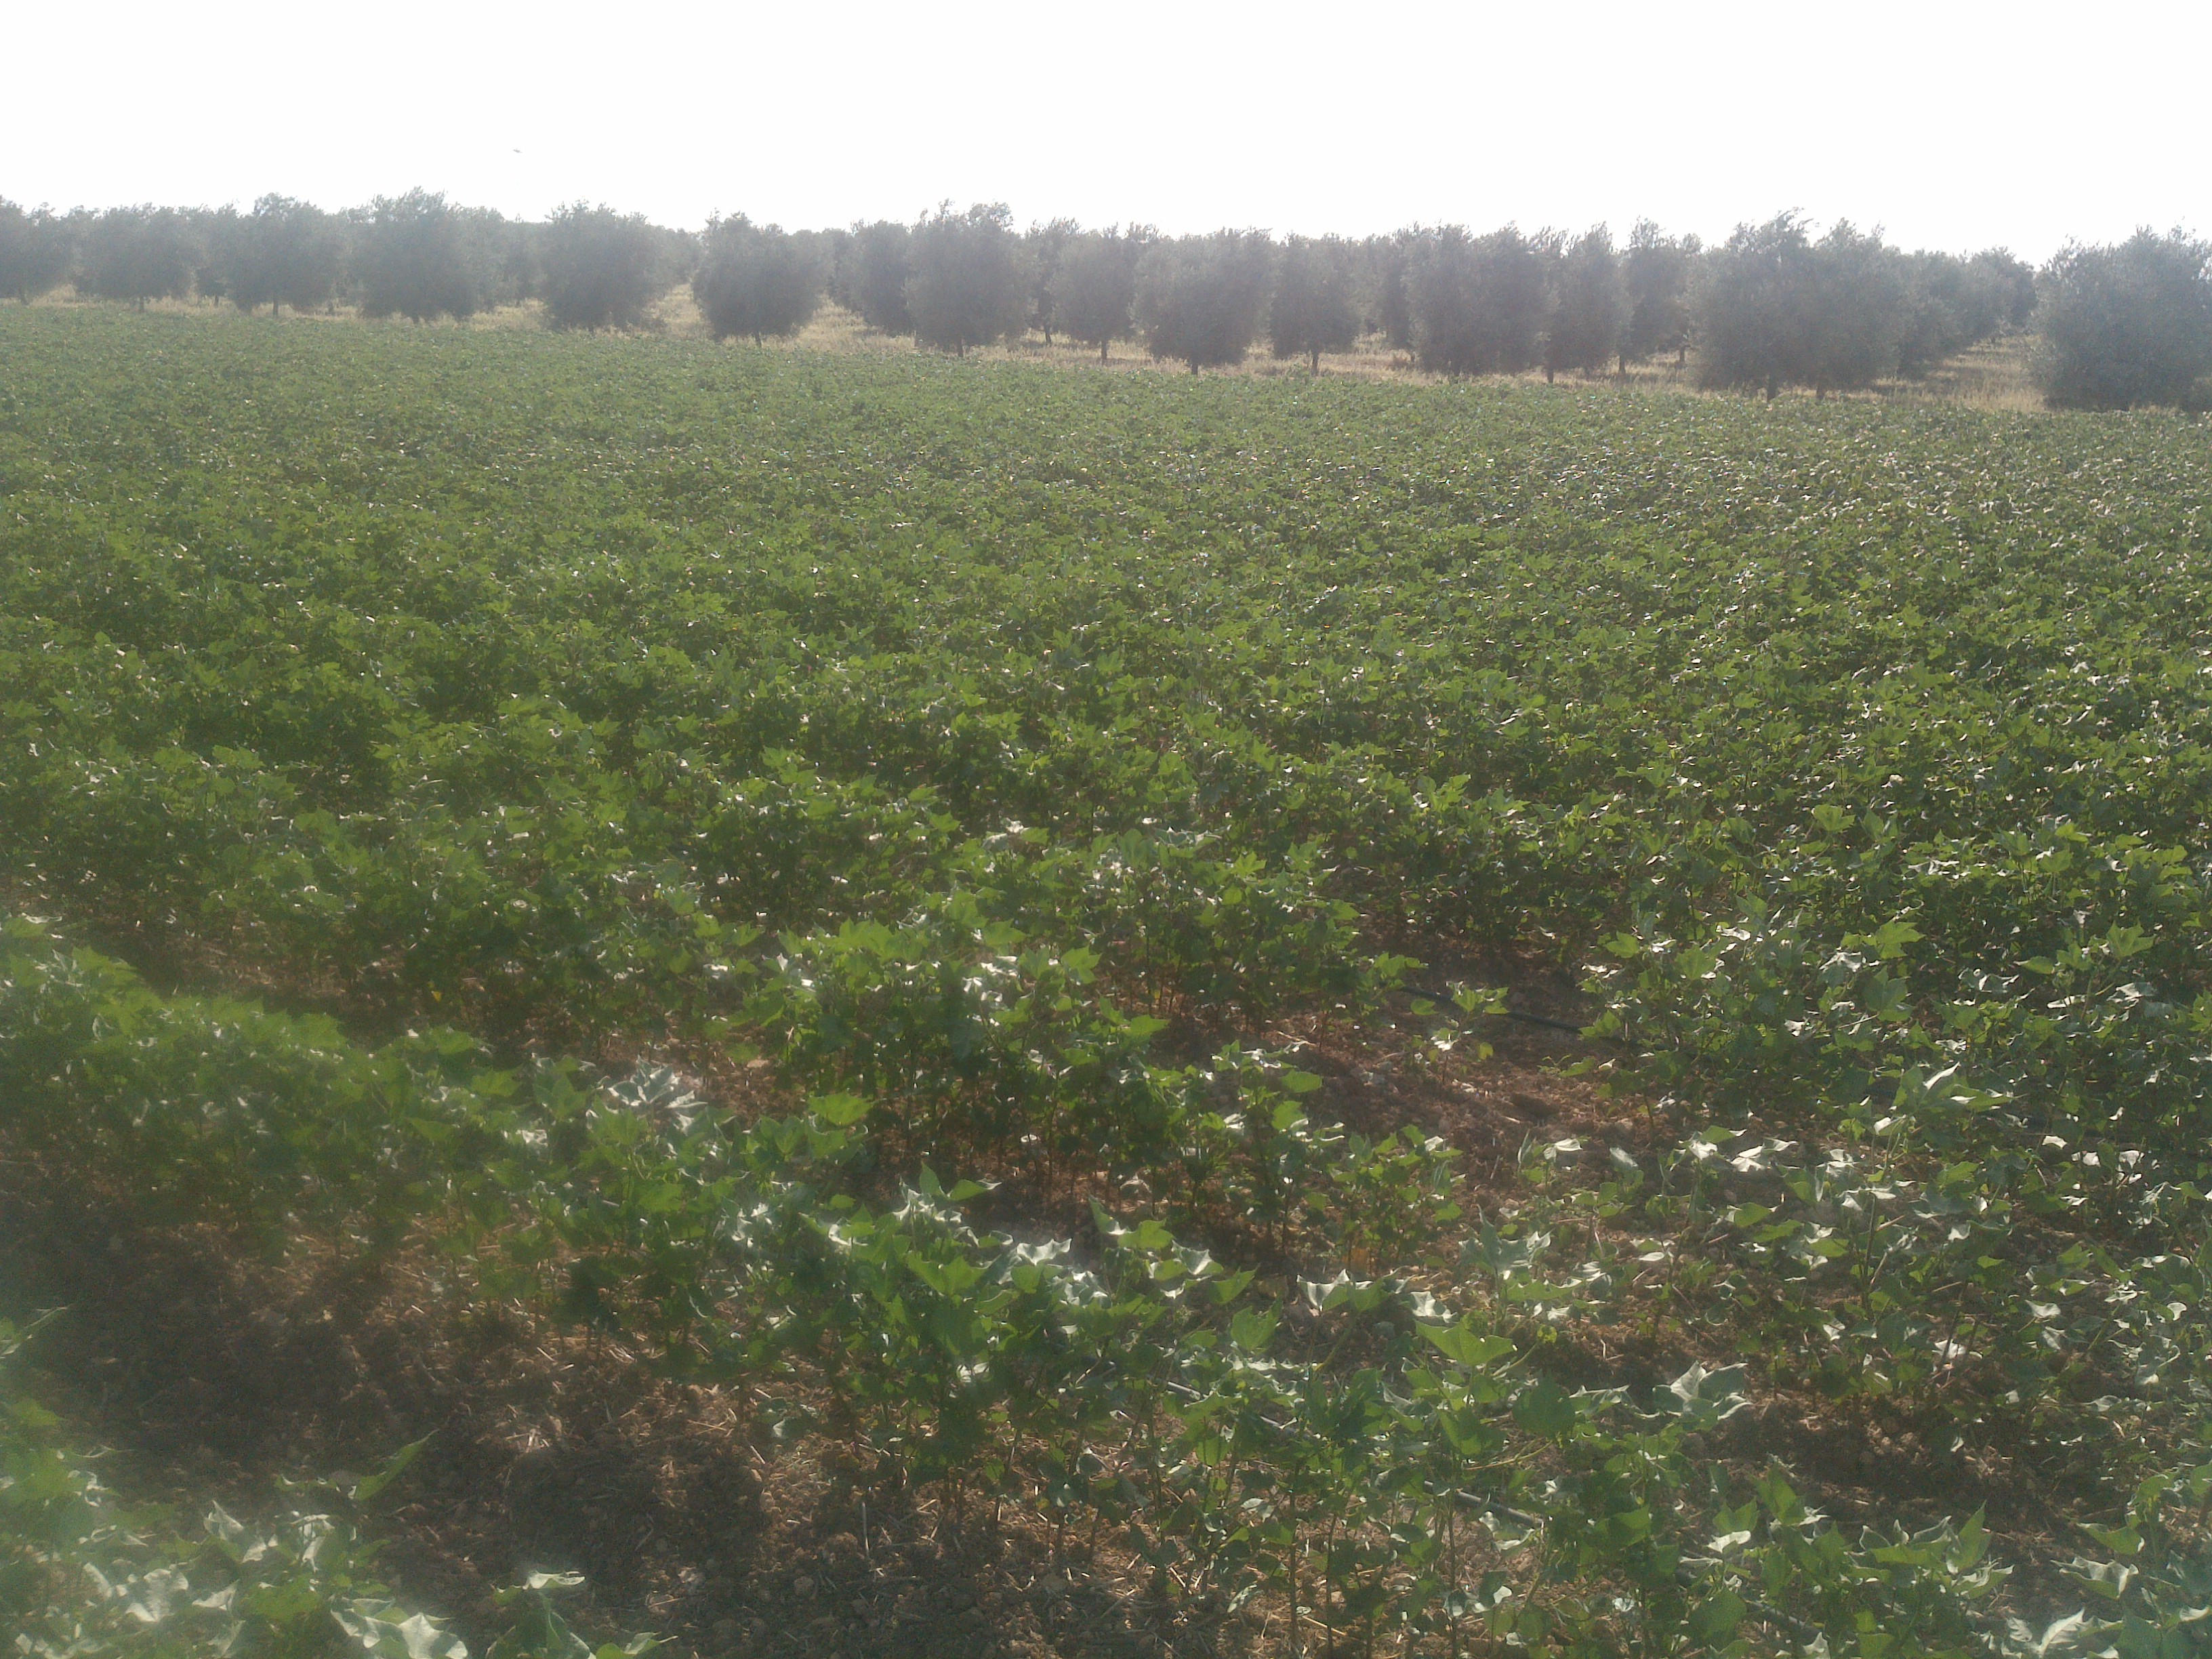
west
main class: Cropland
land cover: Cotton
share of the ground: 50 - 75 %
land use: Agriculture (excluding fallow land and kitchen gardens)
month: July
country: ES
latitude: 37.4397
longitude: -4.8478
